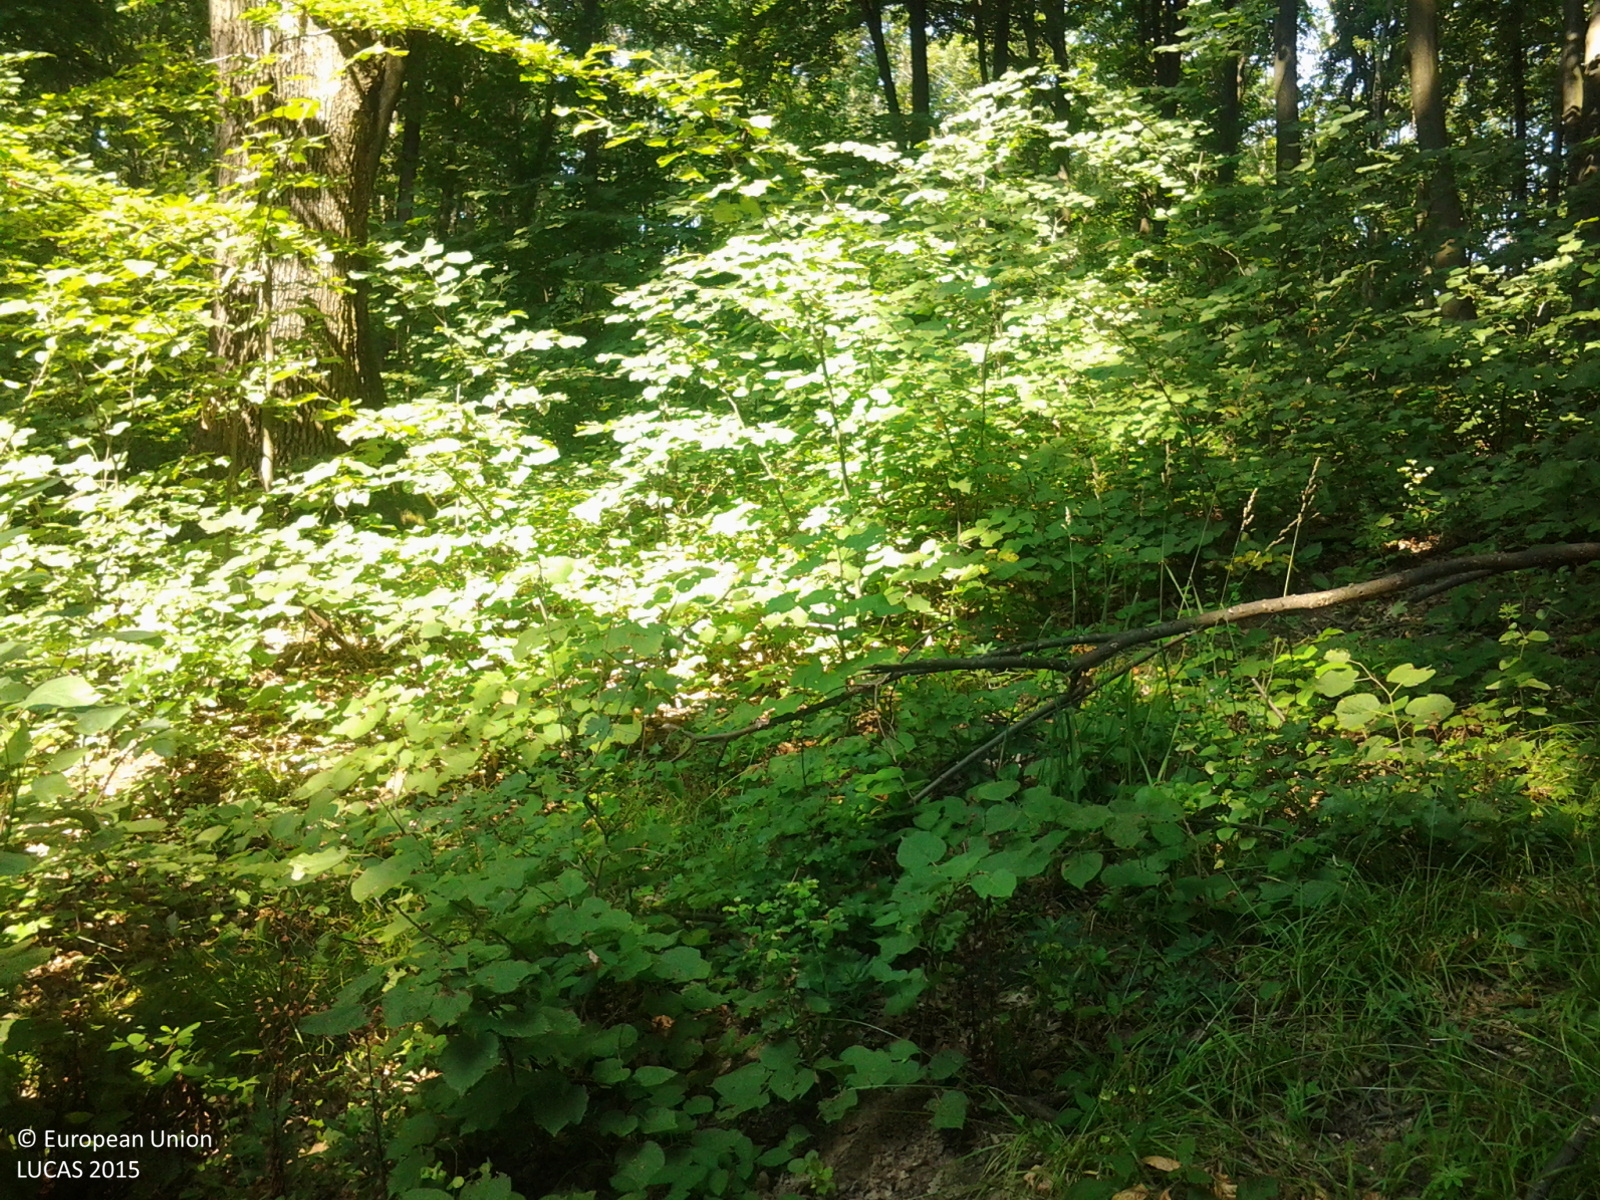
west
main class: Woodland
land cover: Broadleaved woodland
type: mesophytic deciduous forest
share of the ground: > 75 %
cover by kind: broadleaved forest trees 75 %, shrubs 25 %
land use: Forestry
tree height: > 5 m
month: August
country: HU
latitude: 46.2545
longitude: 17.6974
